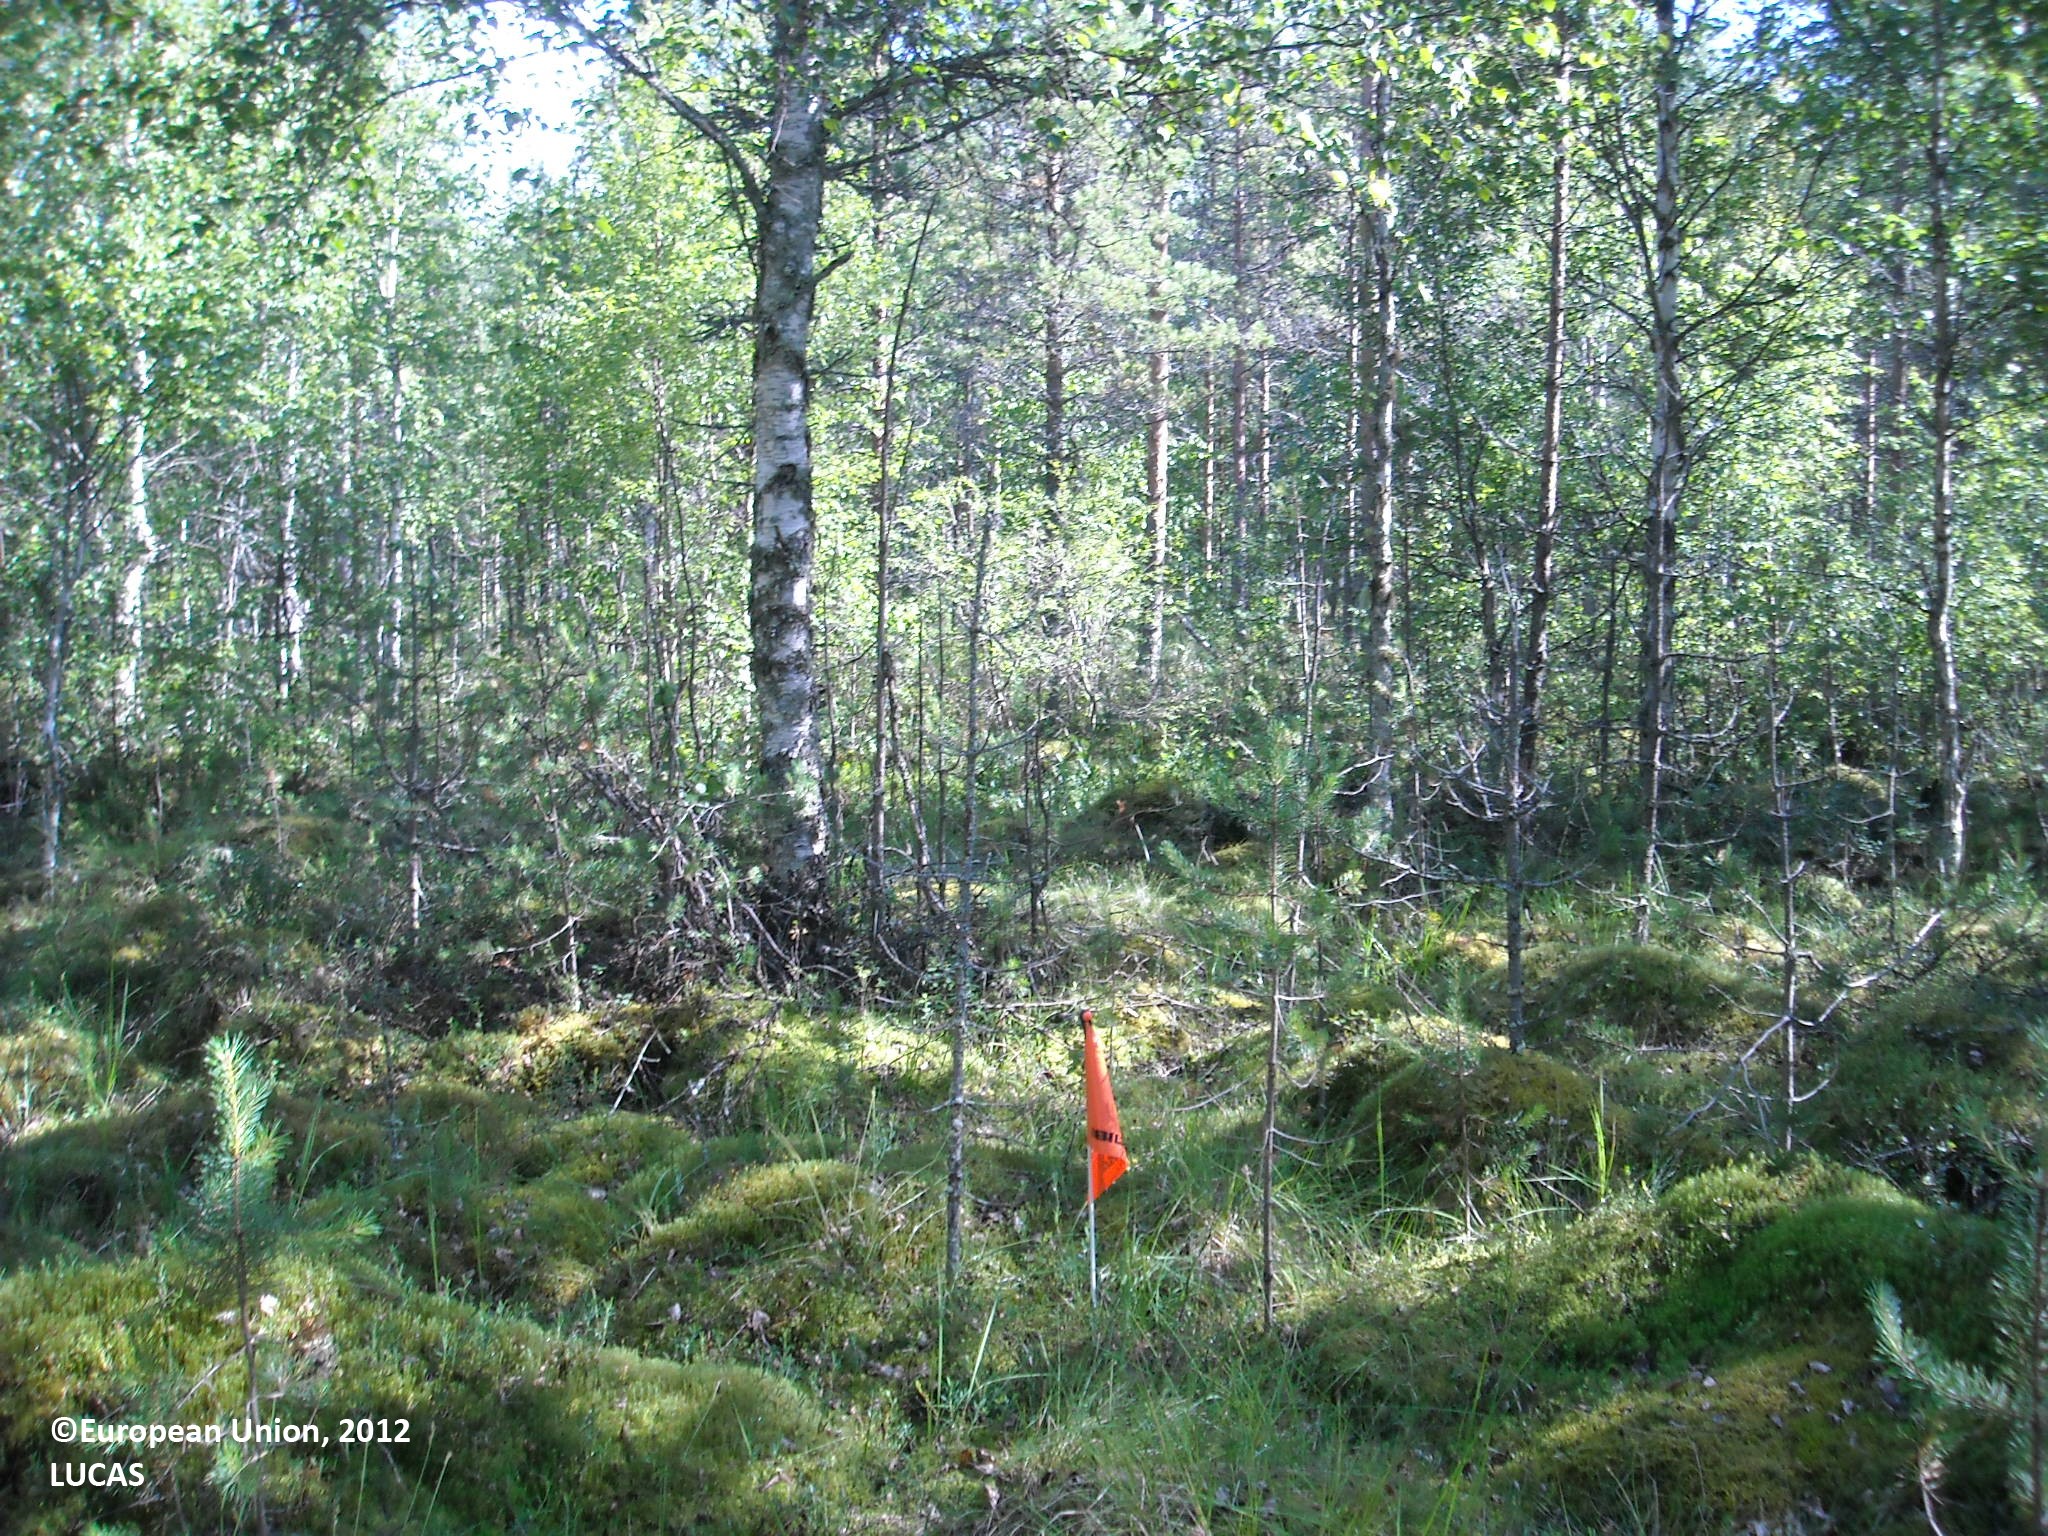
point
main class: Woodland
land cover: Pine dominated mixed woodland
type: mire and swamp forests
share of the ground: > 75 %
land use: Forestry
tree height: > 5 m
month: July
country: FI
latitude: 65.0695
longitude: 27.5066
